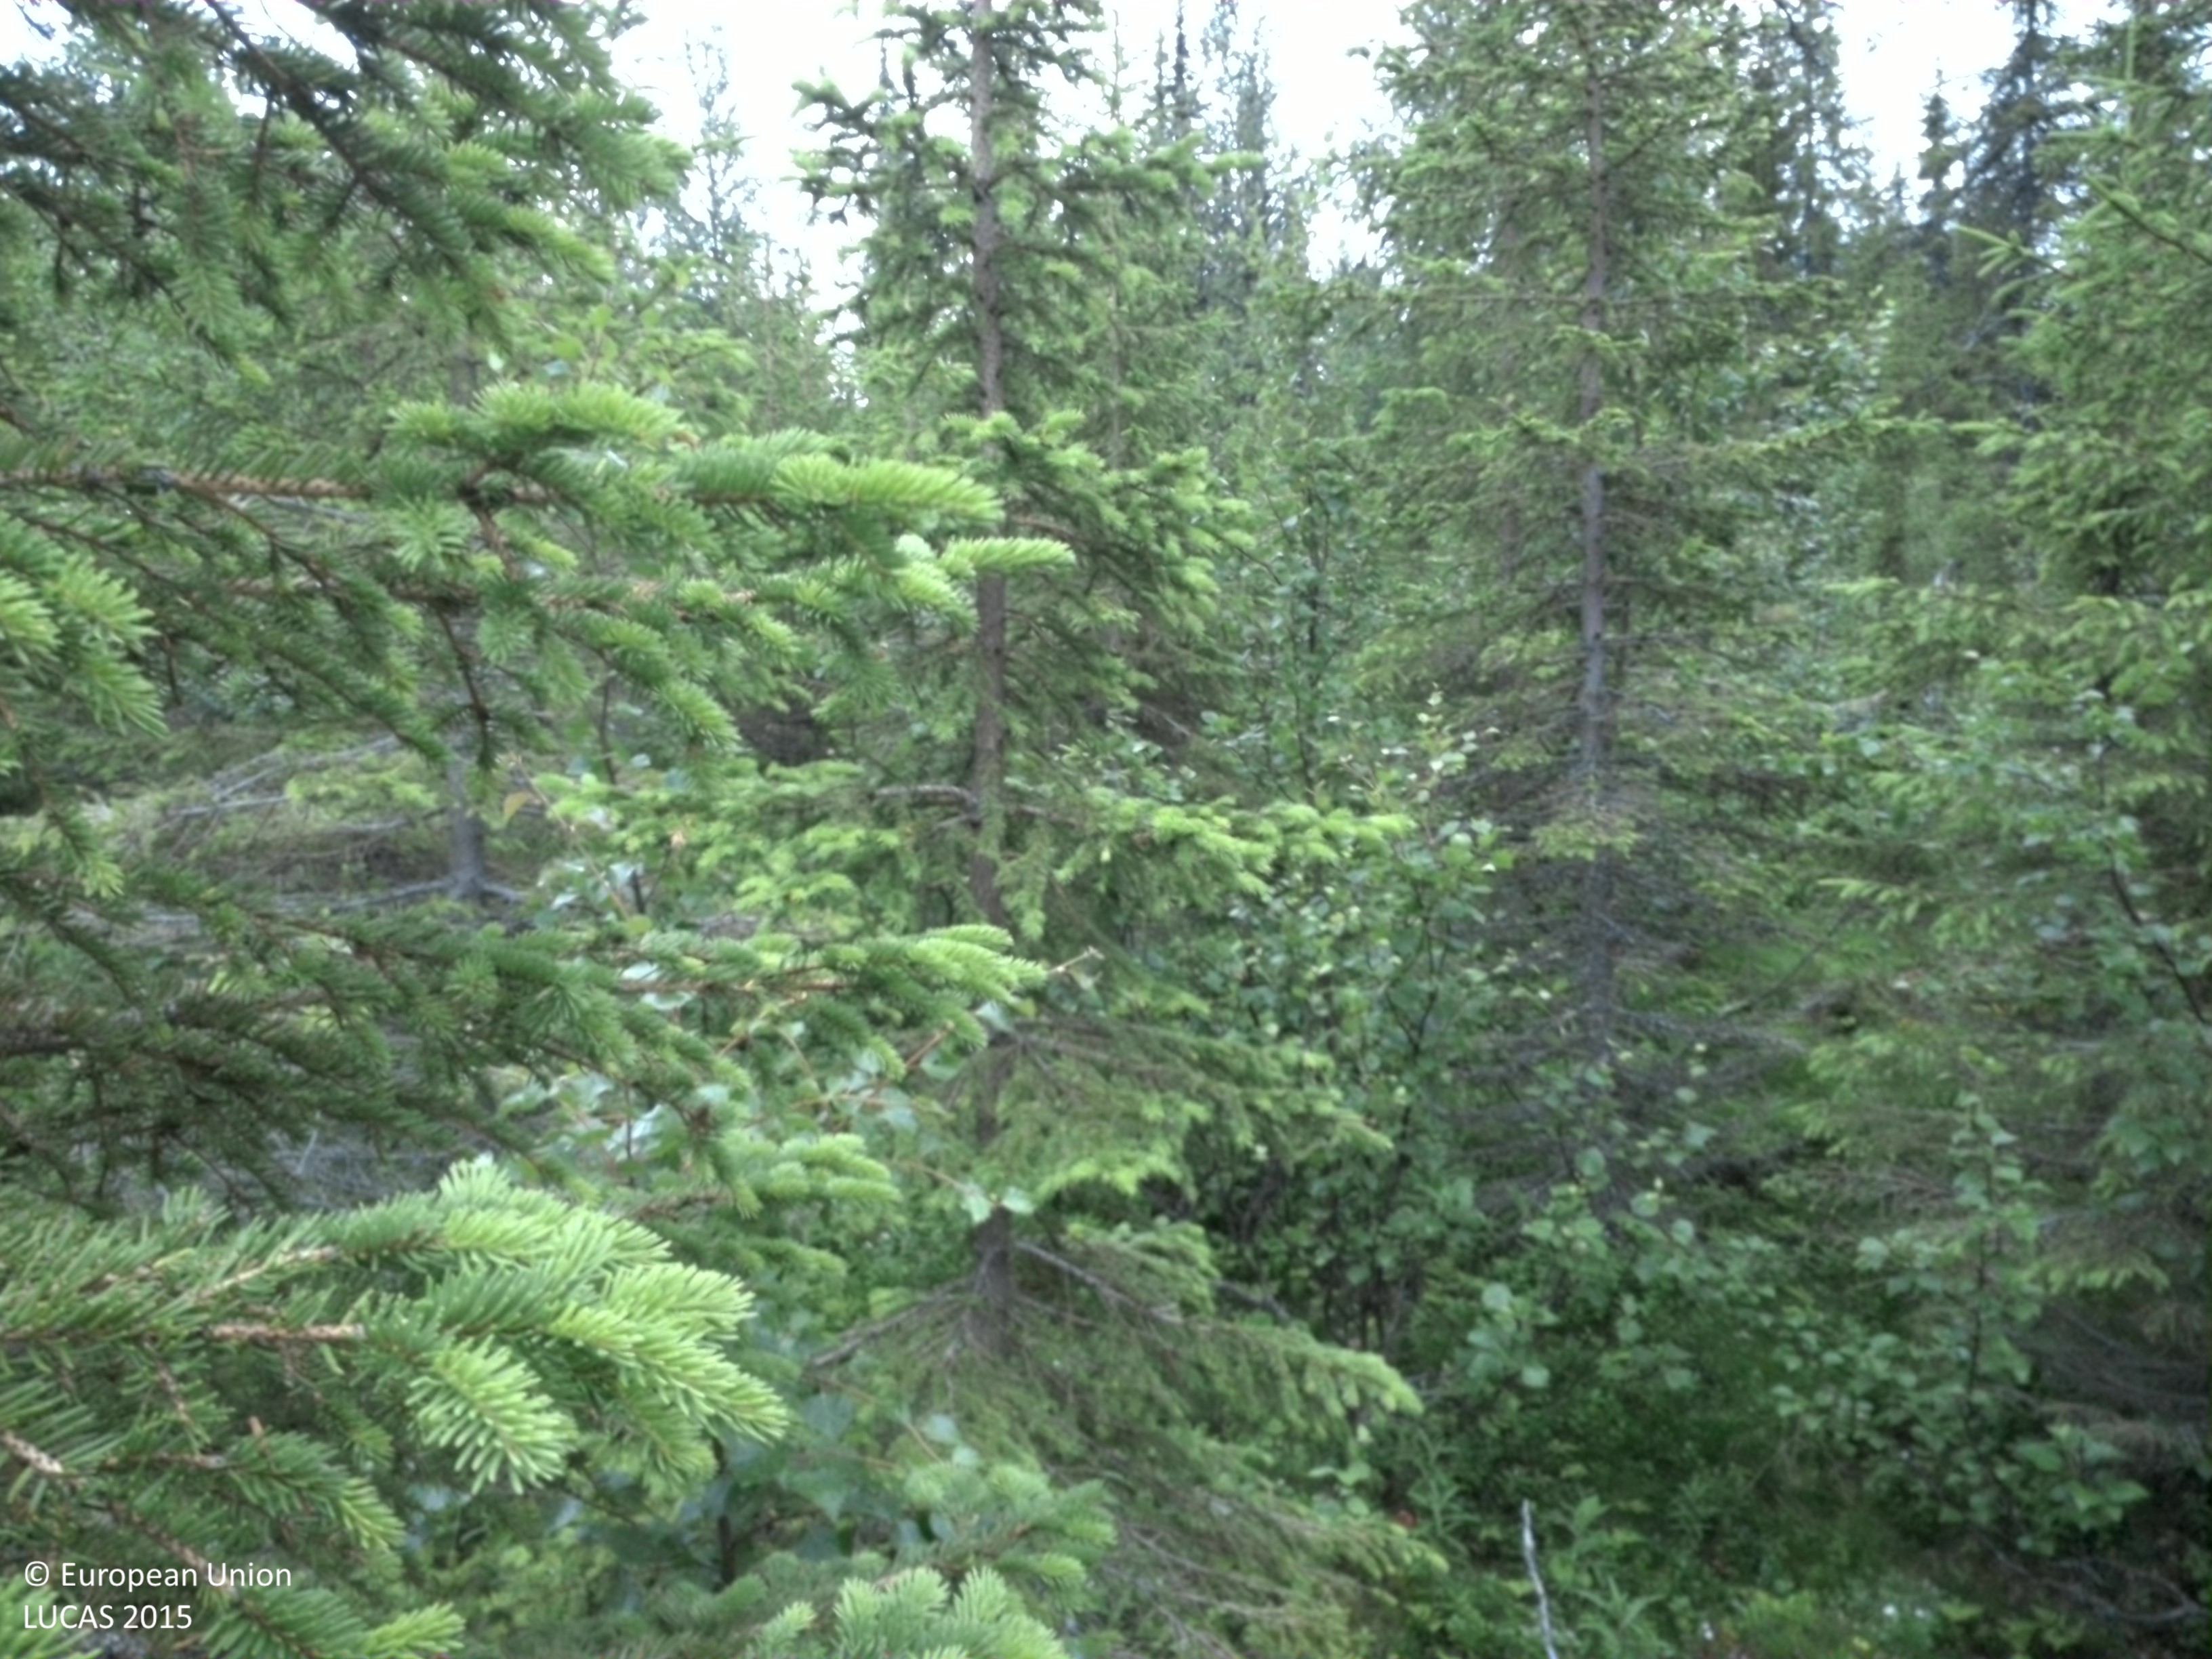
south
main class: Woodland
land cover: Spruce dominated mixed woodland
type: boreal forest
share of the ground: 25 - 50 %
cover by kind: herbaceous plants 30 %, coniferous forest trees 25 %, shrubs 25 %, broadleaved forest trees 10 %, lichens and mosses 10 %
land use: Forestry
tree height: < 5 m
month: August
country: SE
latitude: 64.9715
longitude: 15.5389
